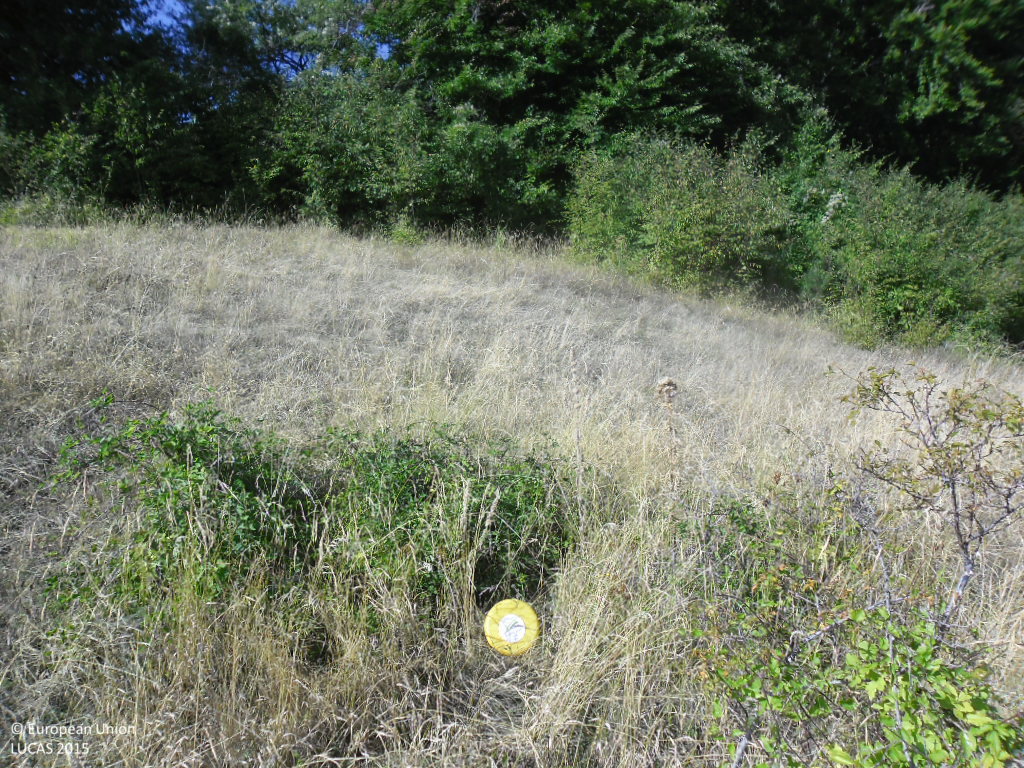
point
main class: Grassland
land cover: Grassland with sparse tree/shrub cover
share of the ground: > 75 %
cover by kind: herbaceous plants 90 %, broadleaved forest trees 5 %, shrubs 5 %
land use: Agriculture (excluding fallow land and kitchen gardens)
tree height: < 5 m
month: September
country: BG
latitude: 41.8737
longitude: 22.9494
